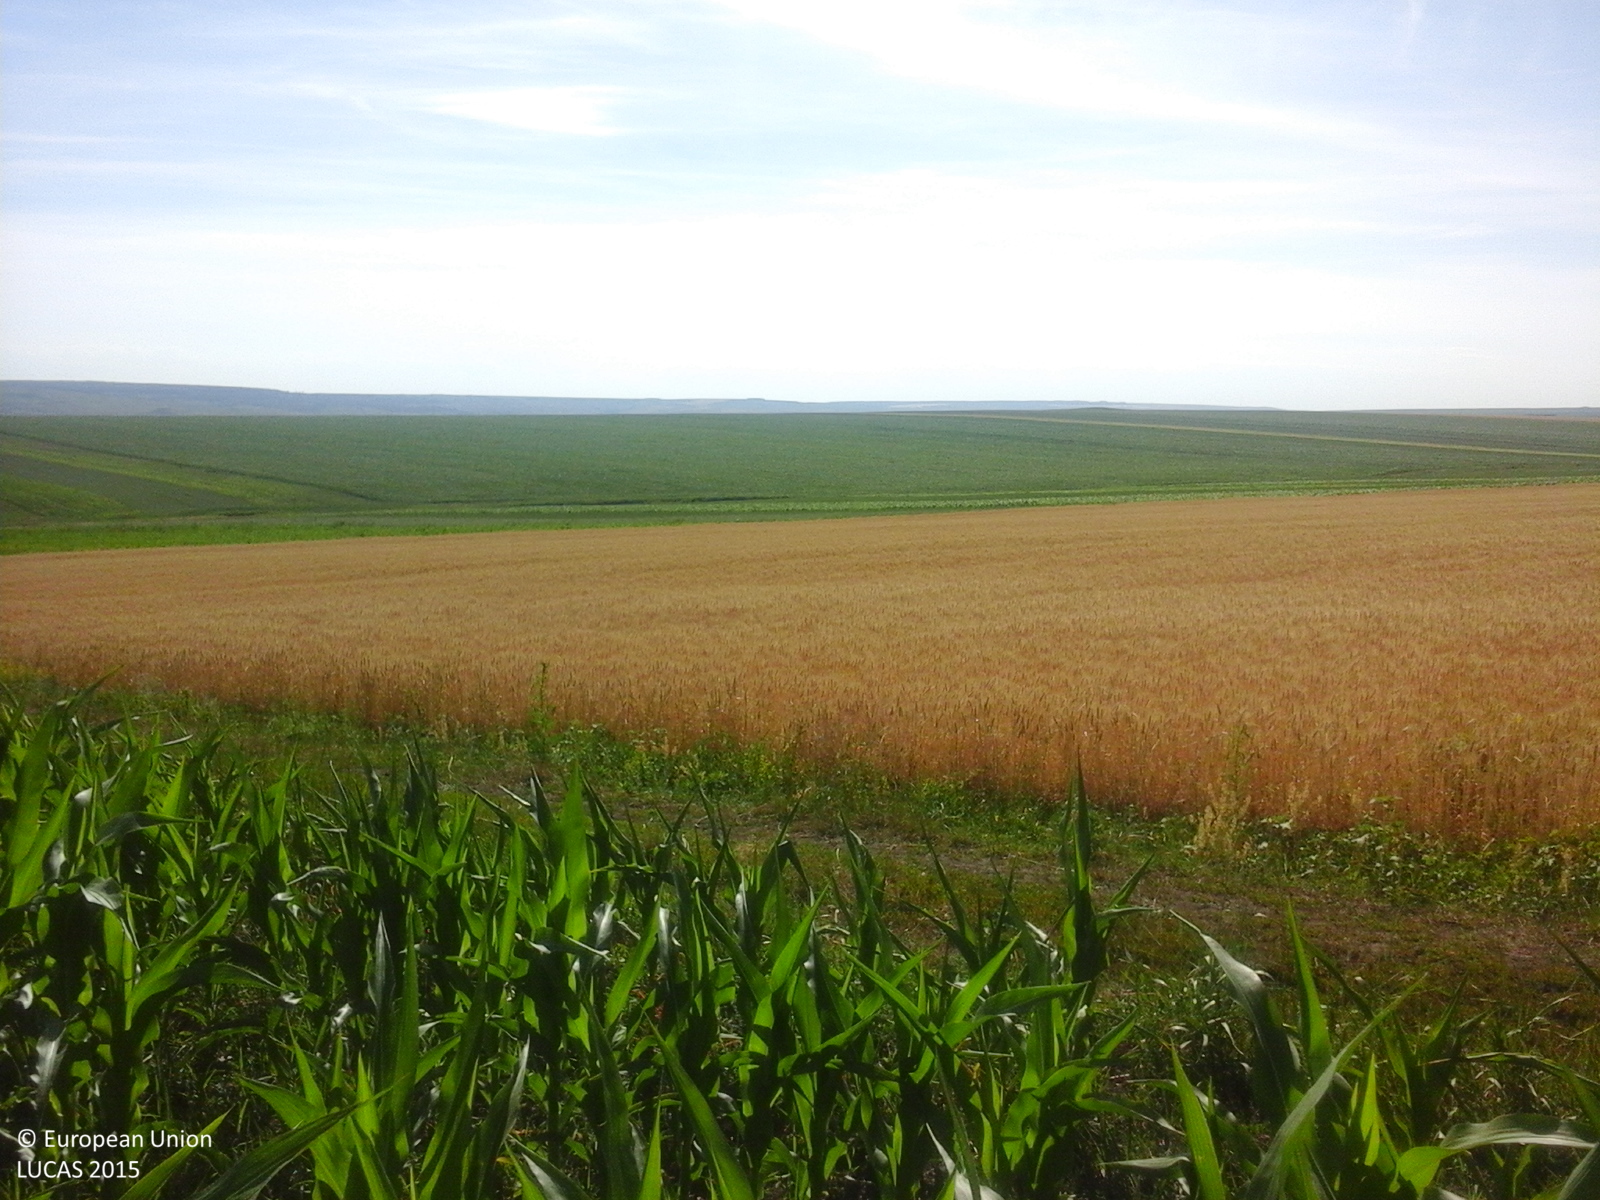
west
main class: Cropland
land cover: Maize
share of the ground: 50 - 75 %
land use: Agriculture (excluding fallow land and kitchen gardens)
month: June
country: RO
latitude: 47.8806
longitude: 27.1320
